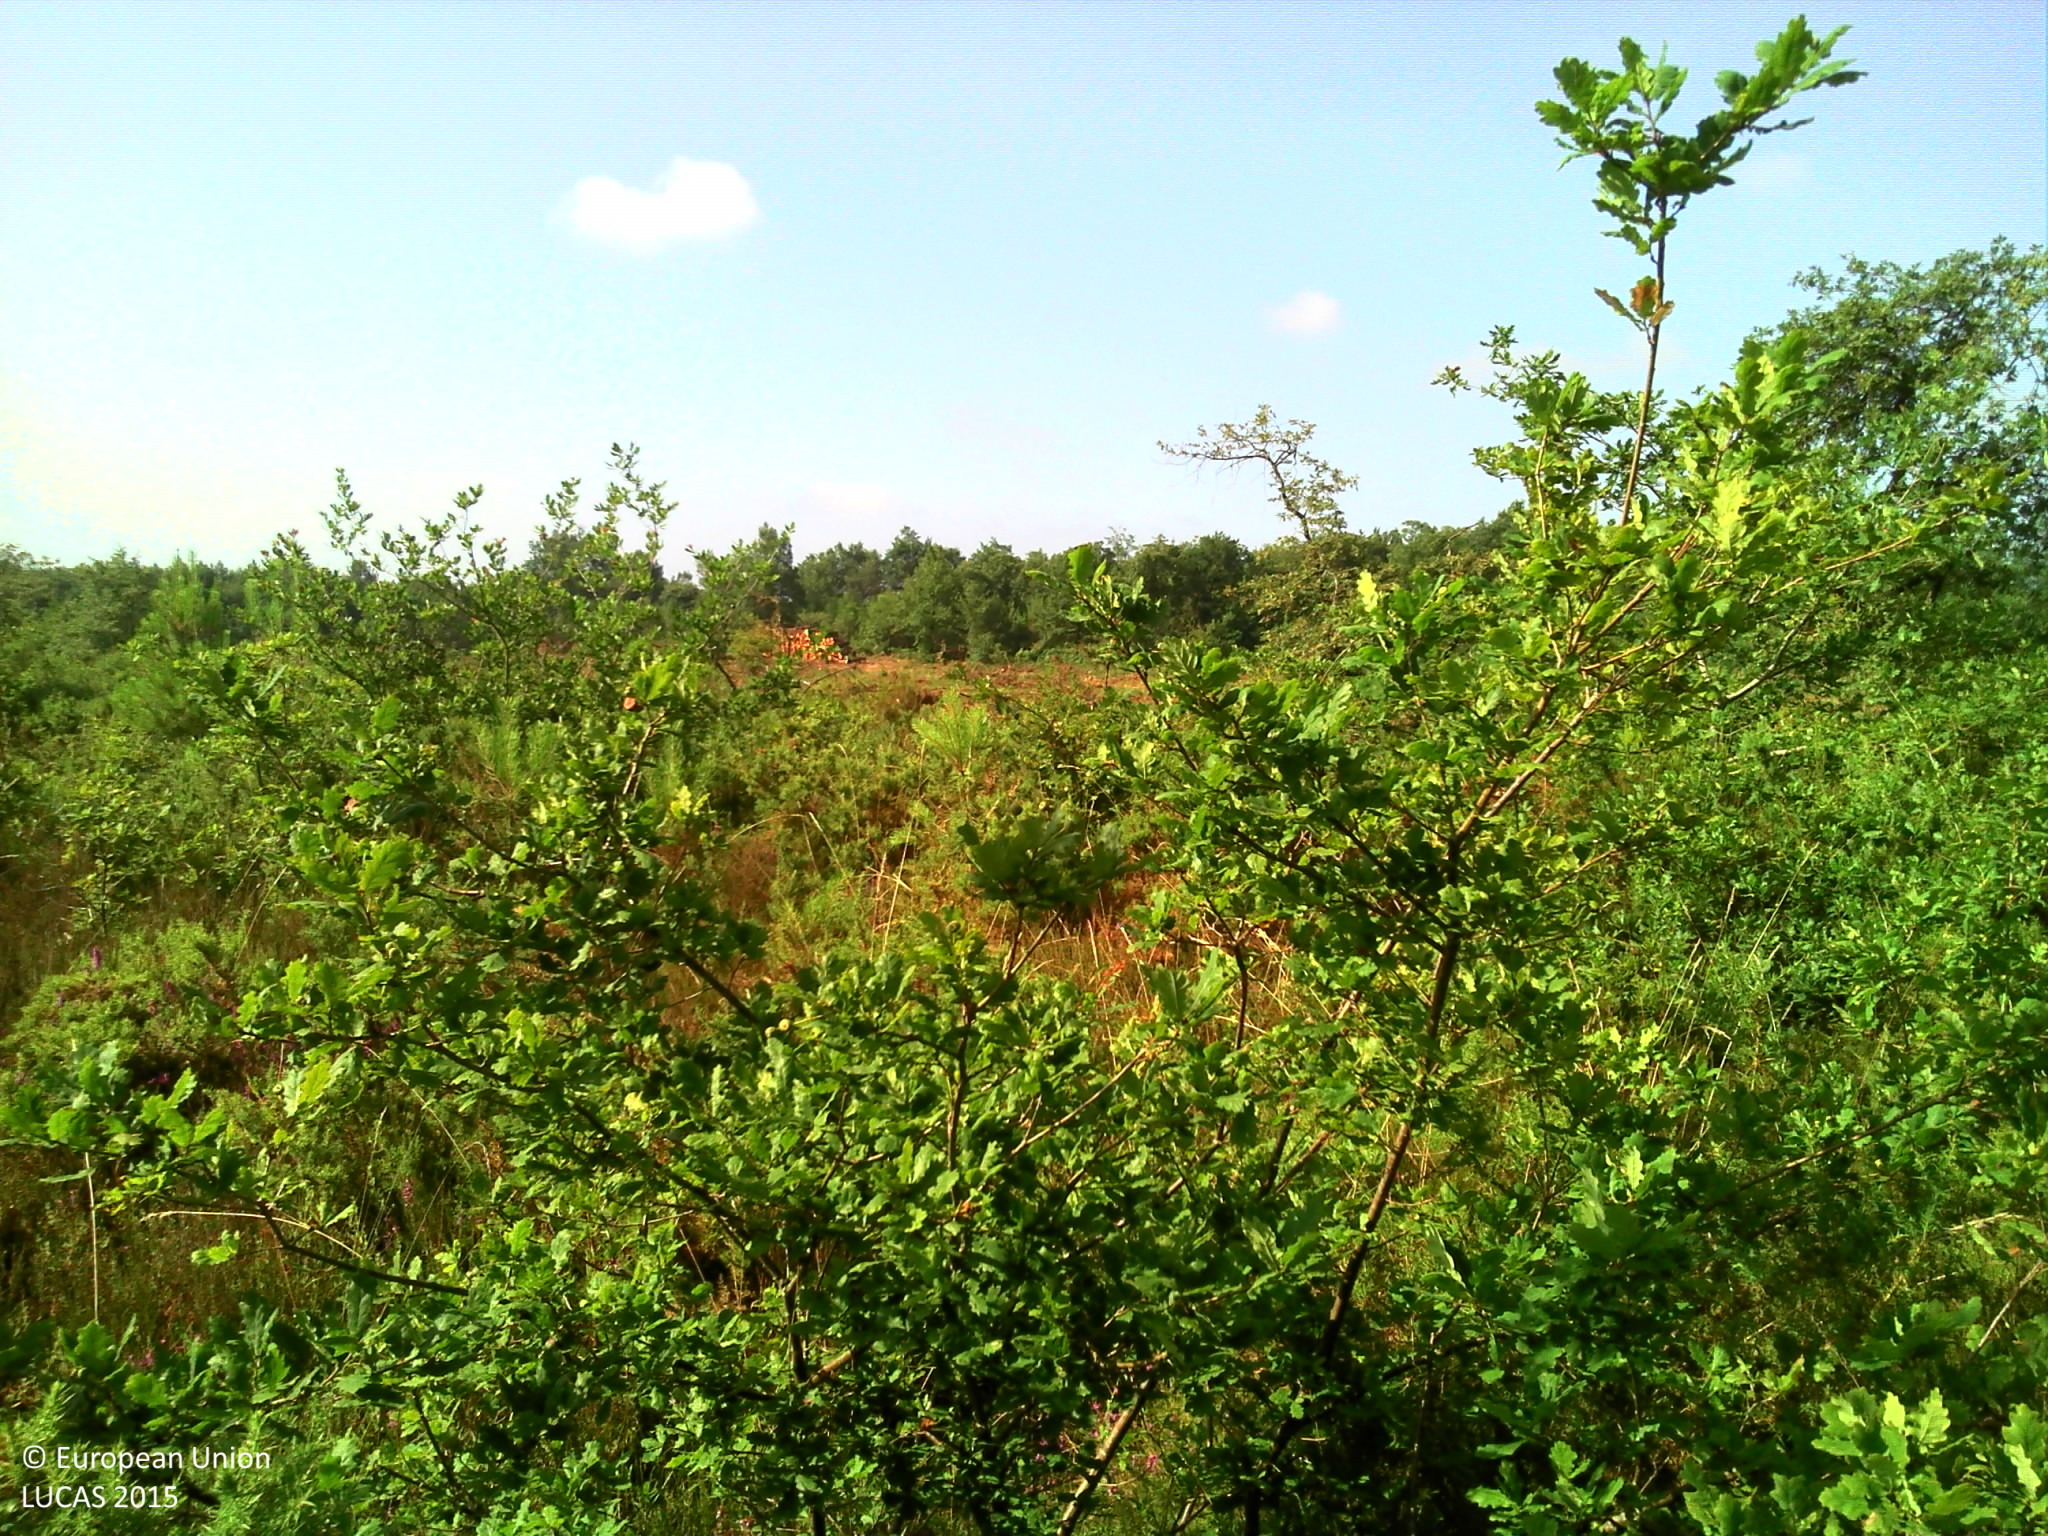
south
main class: Woodland
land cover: Broadleaved woodland
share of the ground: > 75 %
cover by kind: broadleaved forest trees 65 %, shrubs 15 %, herbaceous plants 15 %, coniferous forest trees 5 %
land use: Forestry
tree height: > 5 m
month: July
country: FR
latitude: 43.7141
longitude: -1.1246
